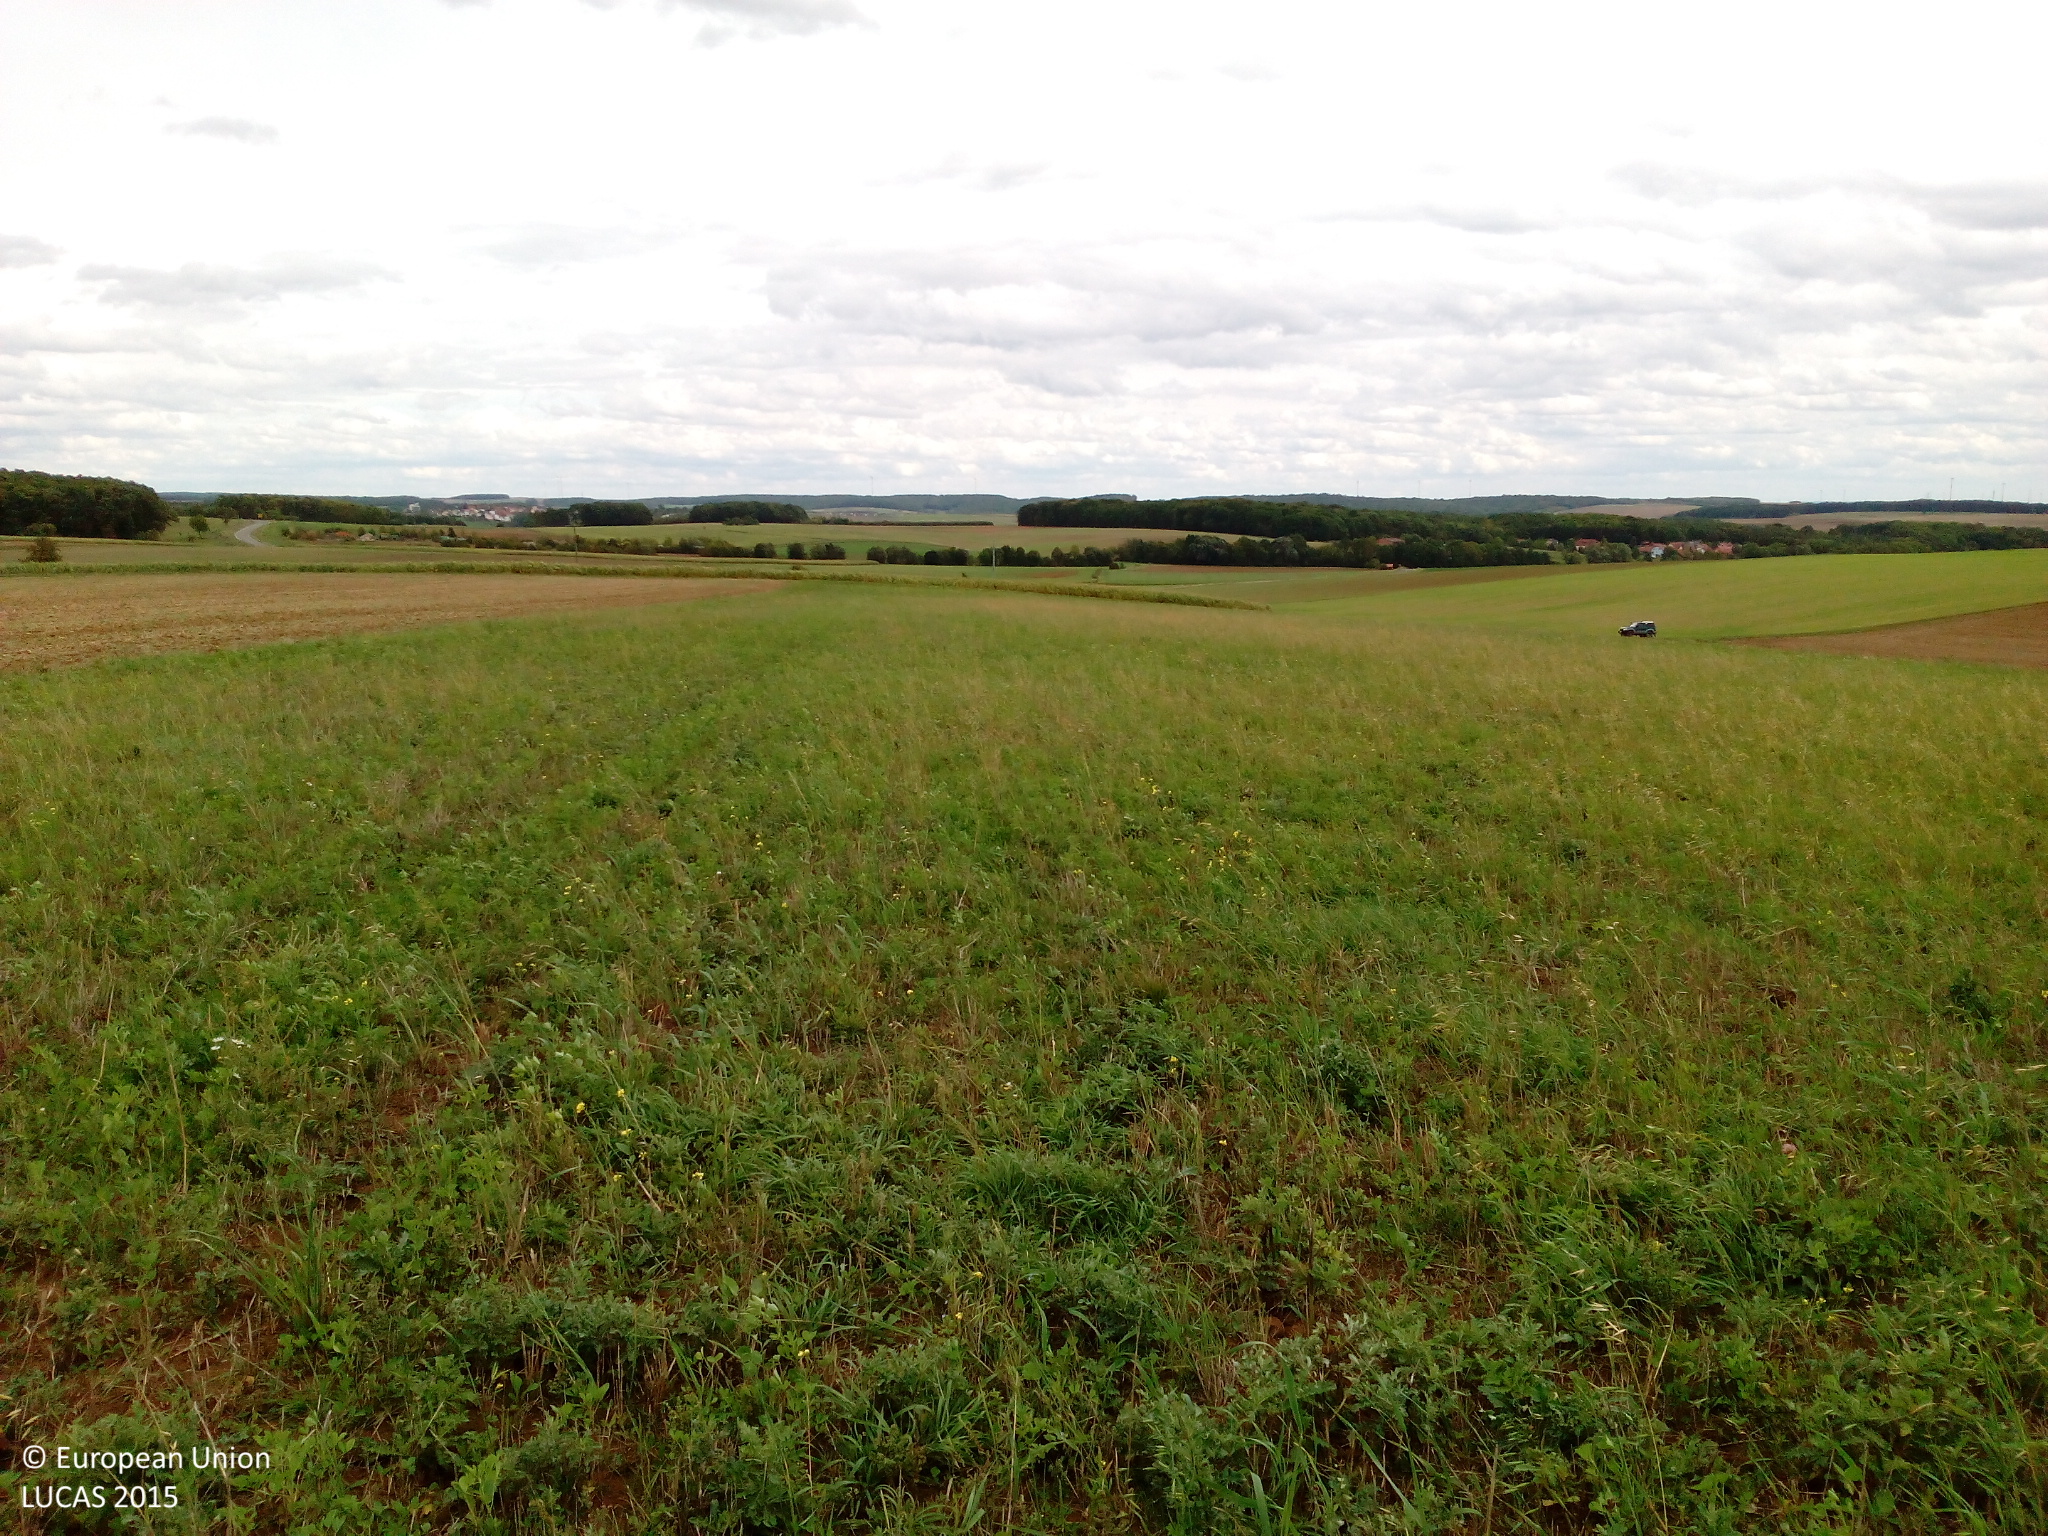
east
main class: Cropland
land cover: Other leguminous and mixtures for fodder
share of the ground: 50 - 75 %
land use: Agriculture (excluding fallow land and kitchen gardens)
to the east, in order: Other leguminous and mixtures for fodder; Grass margins; Tracks; Grass margins; Maize
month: September
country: DE
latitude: 50.0224
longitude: 9.9302
